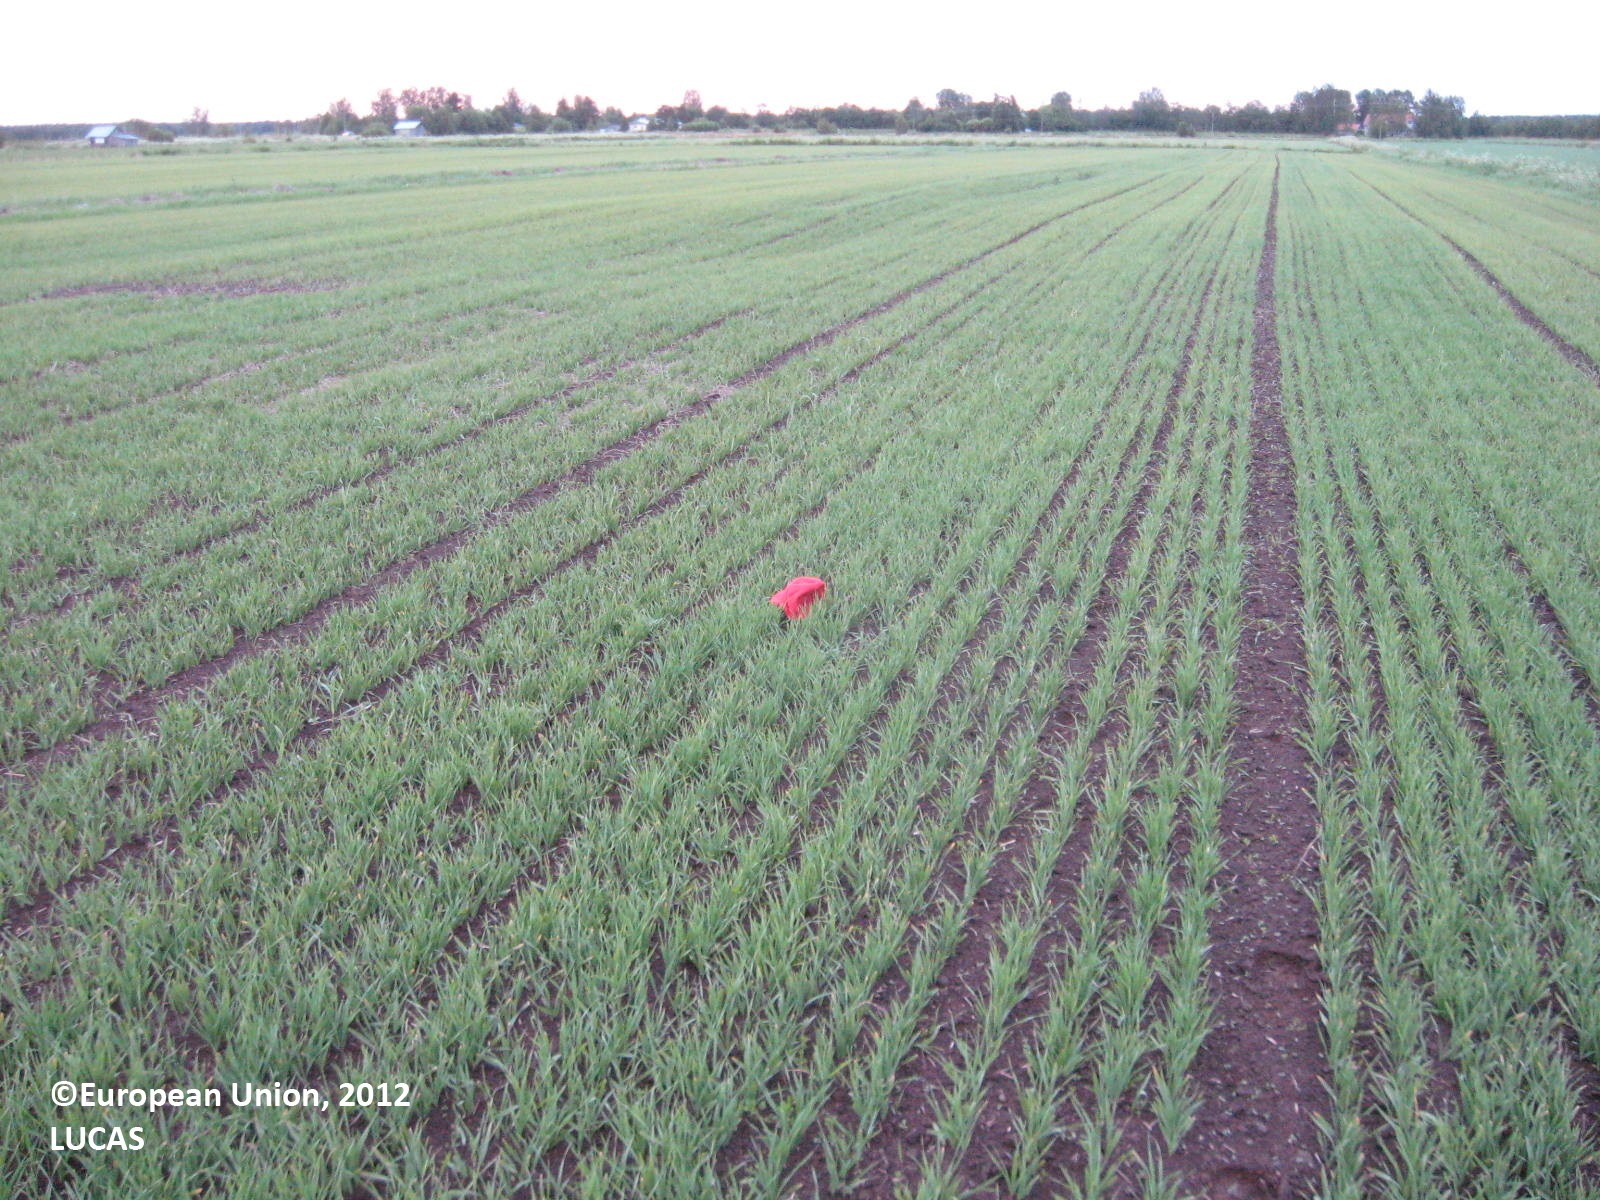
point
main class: Cropland
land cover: Barley
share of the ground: 50 - 75 %
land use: Agriculture (excluding fallow land and kitchen gardens)
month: June
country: FI
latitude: 62.8537
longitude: 22.7671
